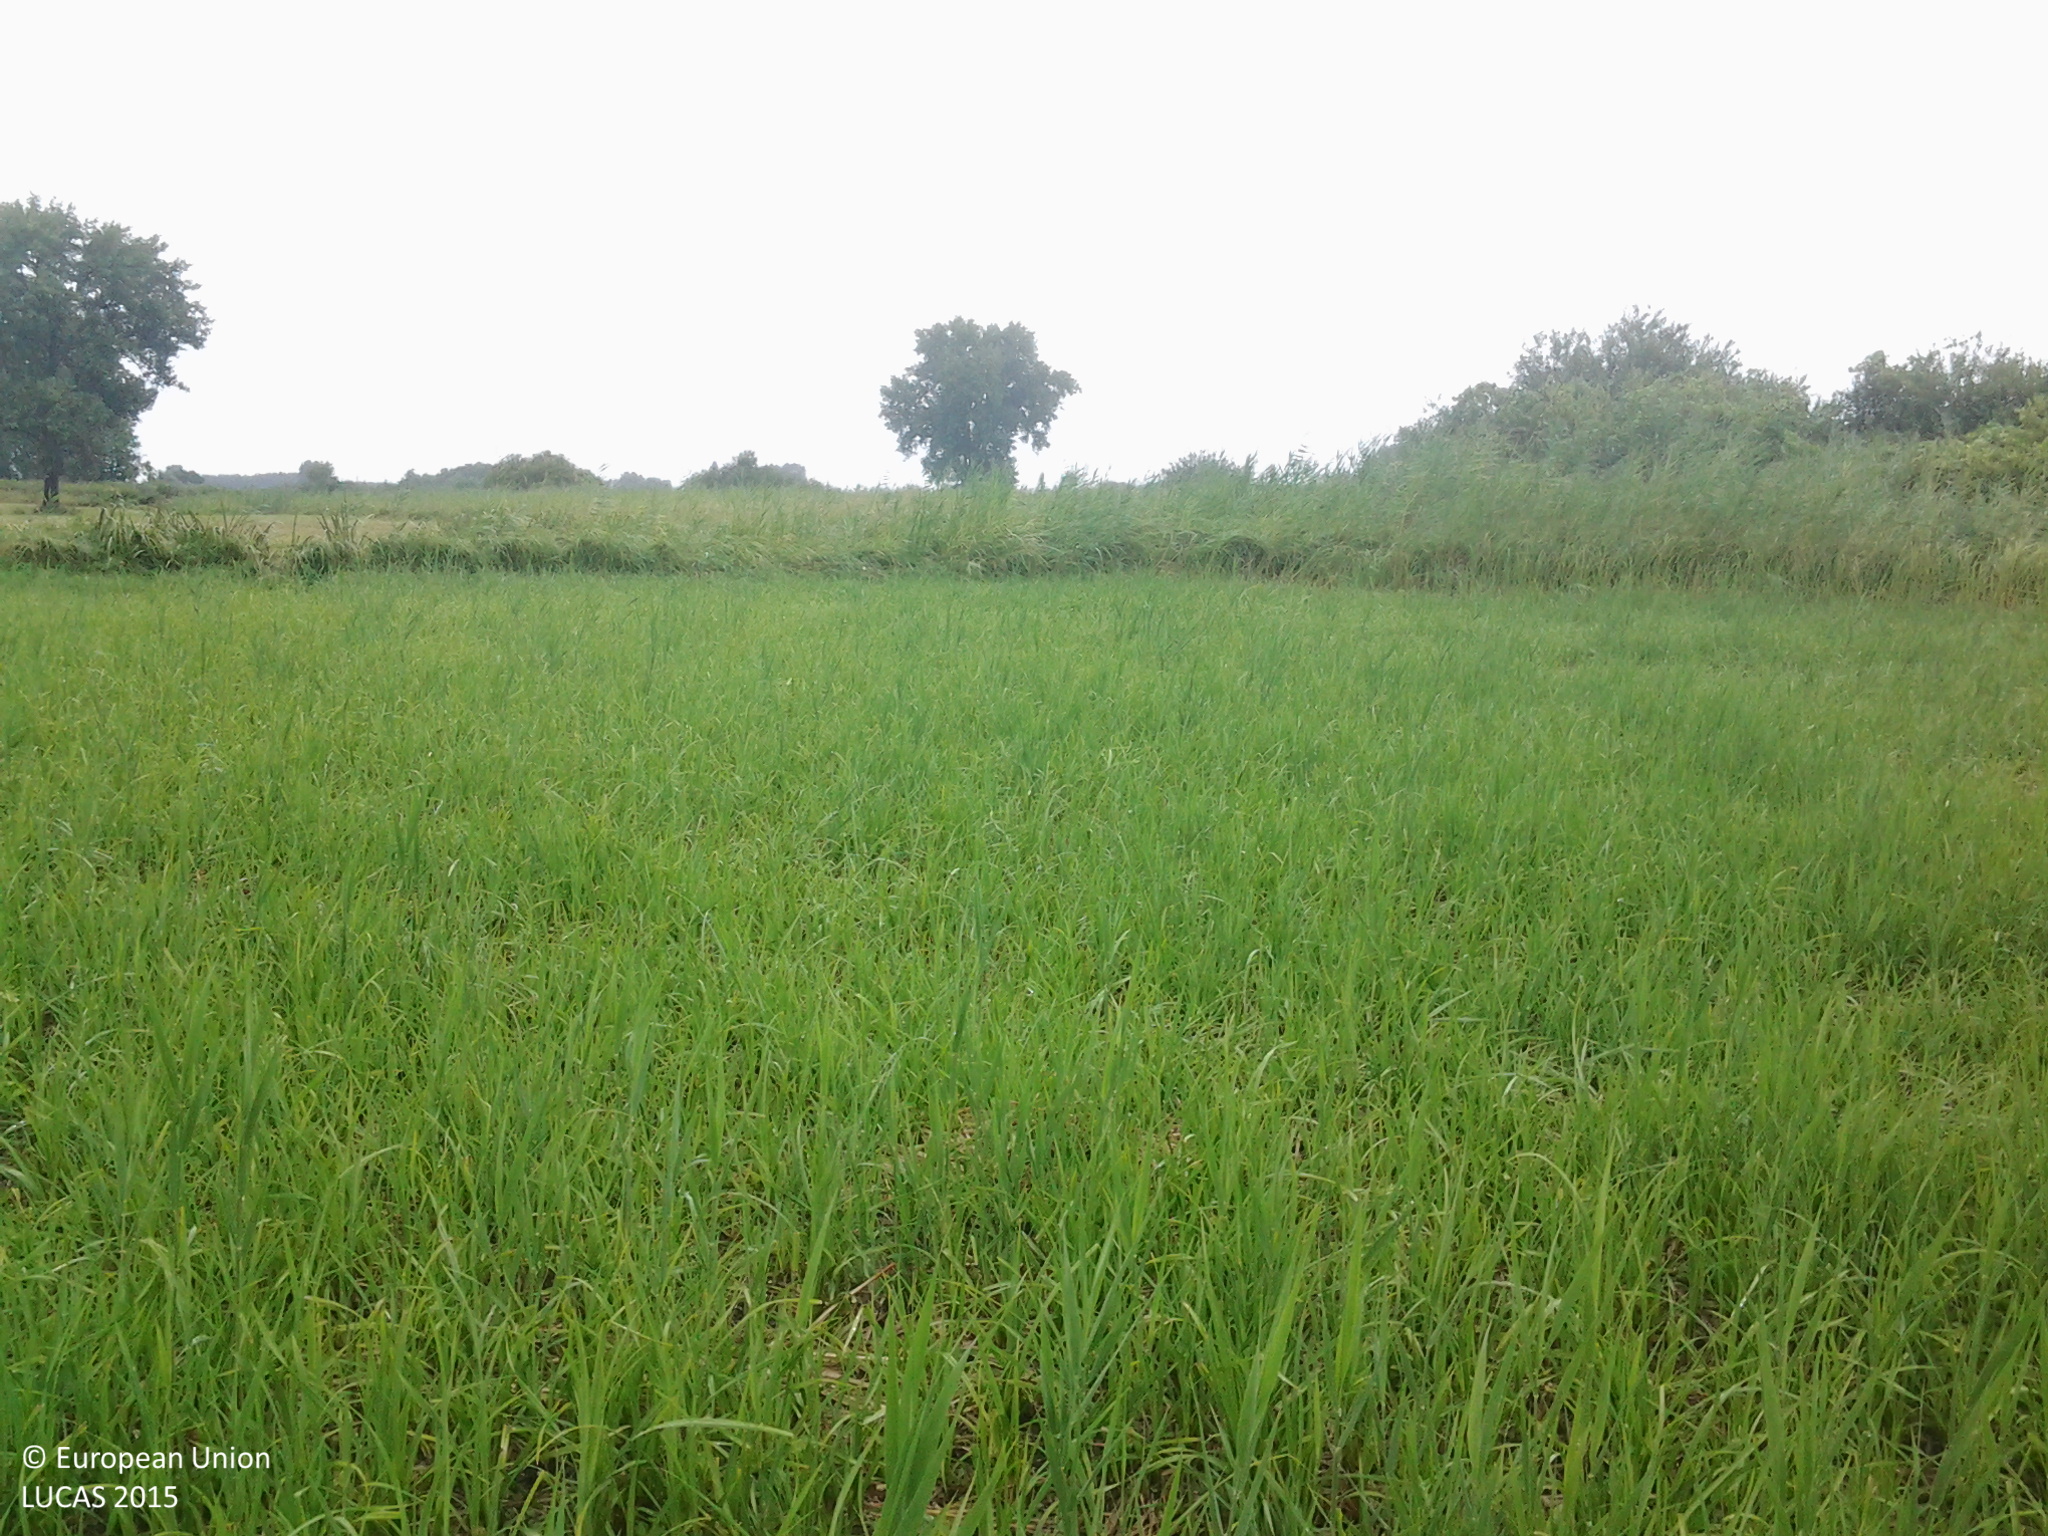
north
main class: Grassland
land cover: Grassland without tree/shrub cover
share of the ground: > 75 %
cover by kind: herbaceous plants 100 %
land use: Agriculture (excluding fallow land and kitchen gardens)
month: July
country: HU
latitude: 46.6738
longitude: 19.2581
